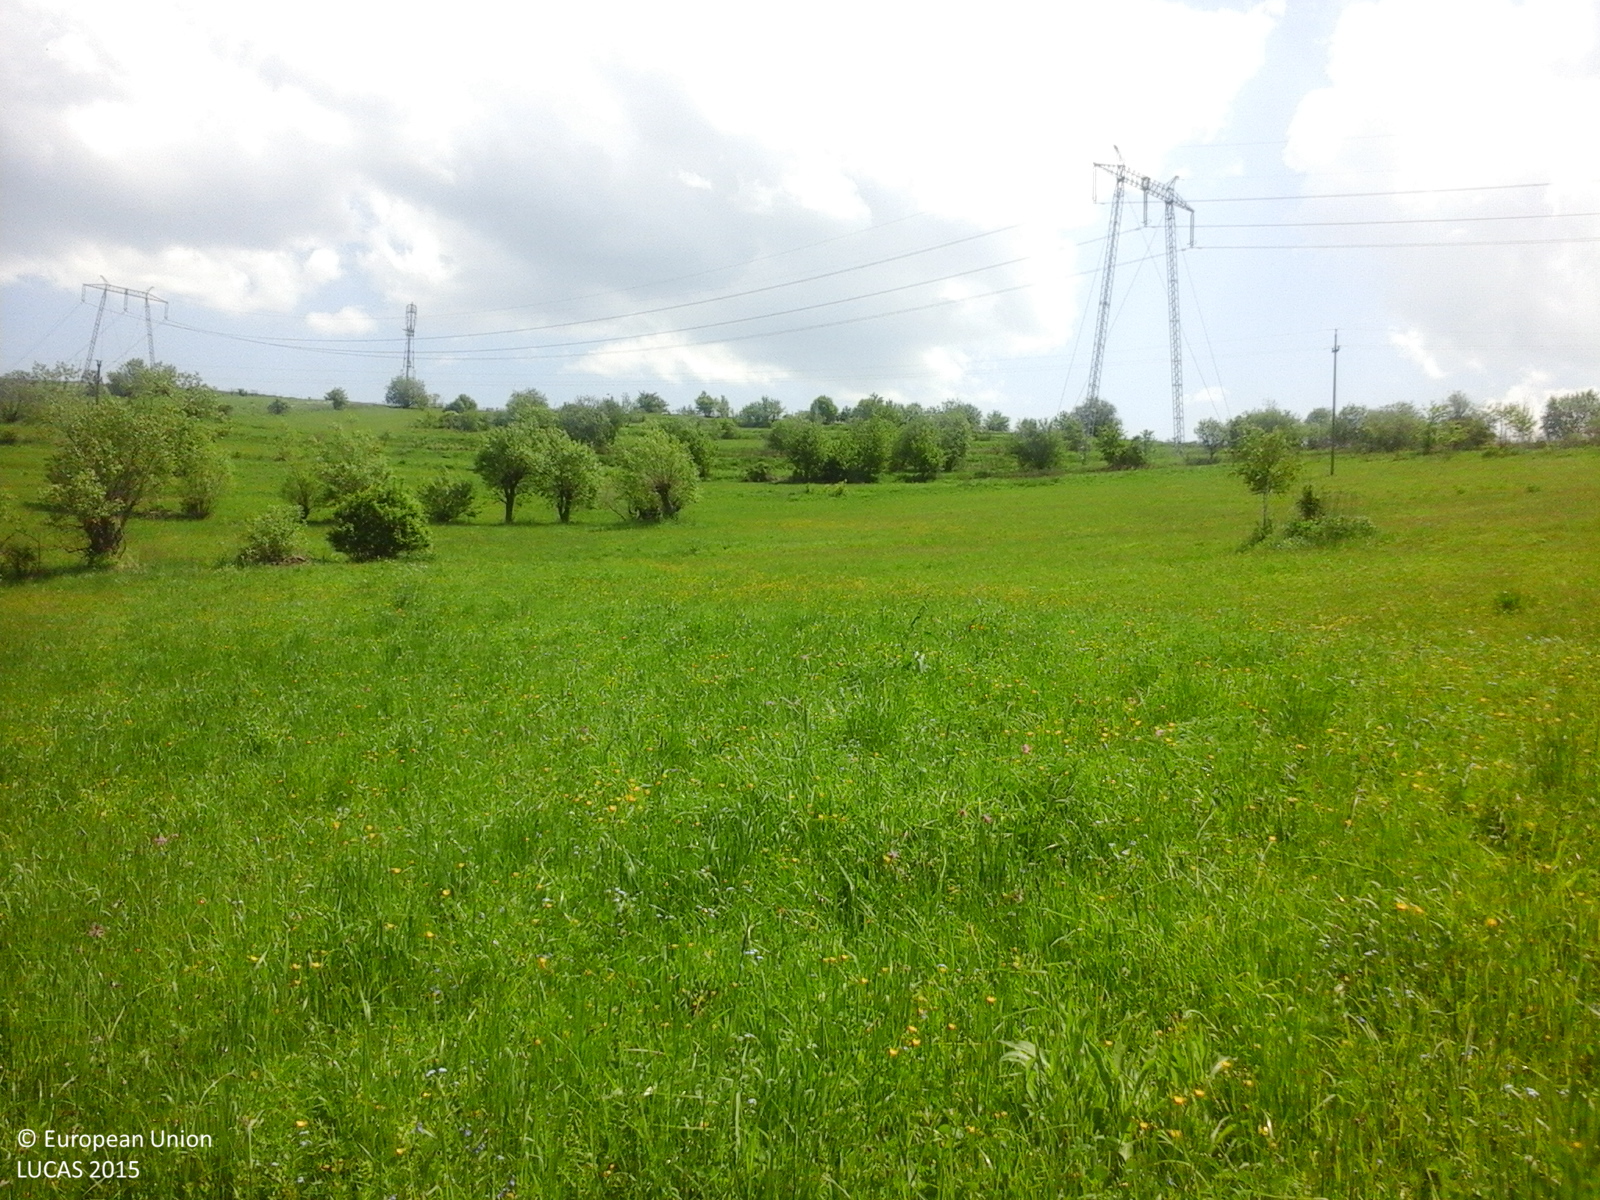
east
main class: Grassland
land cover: Grassland without tree/shrub cover
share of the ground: > 75 %
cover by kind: herbaceous plants 100 %
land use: Agriculture (excluding fallow land and kitchen gardens)
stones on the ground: < 10 %
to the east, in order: Grassland without tree/shrub cover; Grassland with sparse tree/shrub cover; Grassland without tree/shrub cover; Lines of trees; Grassland without tree/shrub cover; Electric lines; Grassland without tree/shrub cover
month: May
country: RO
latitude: 46.0286
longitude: 26.2864
